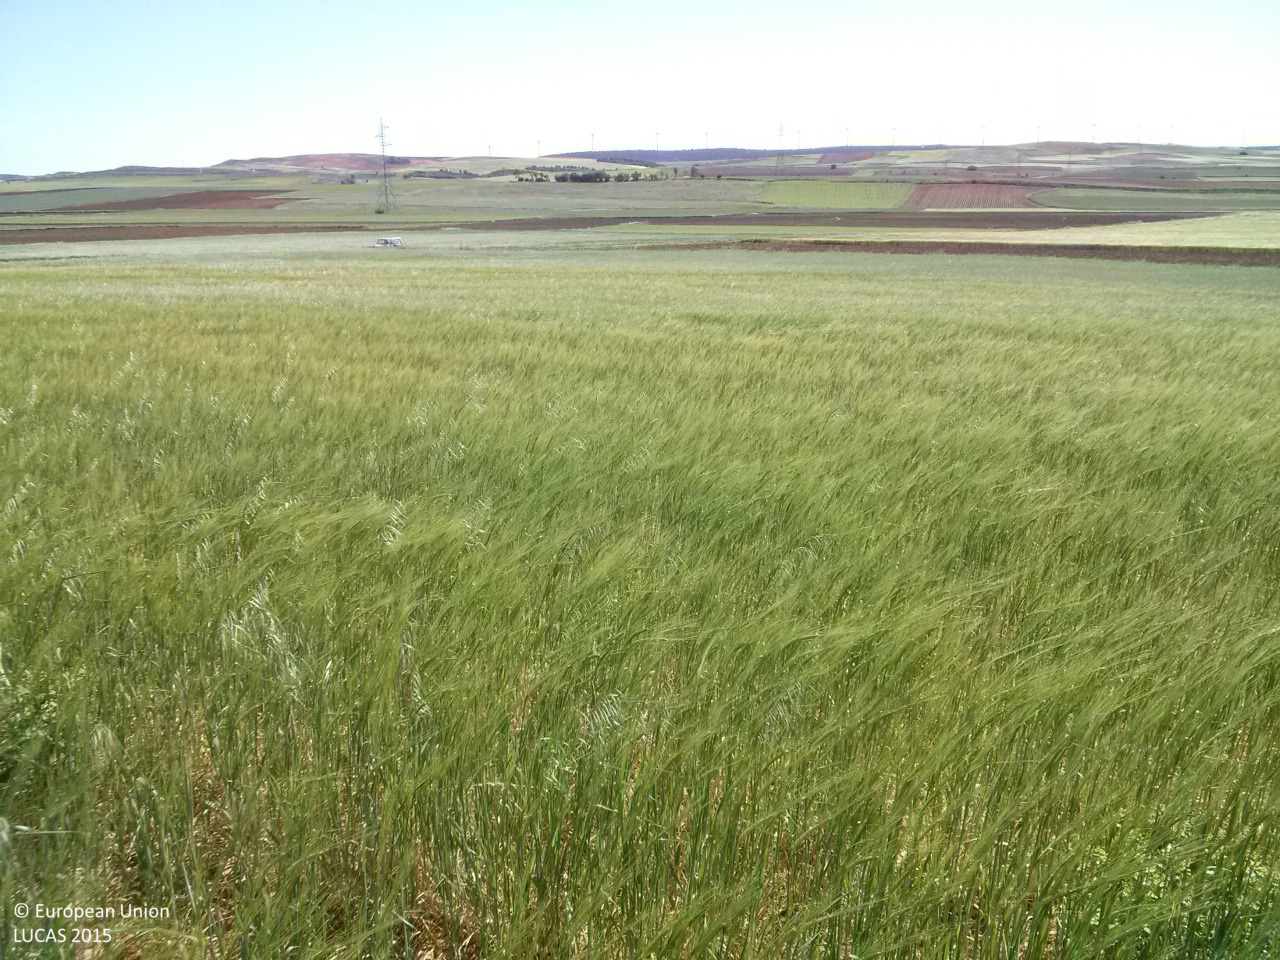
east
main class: Cropland
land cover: Barley
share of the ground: > 75 %
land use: Agriculture (excluding fallow land and kitchen gardens)
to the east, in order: Barley; Grass margins; Sunflower; Barley; Grass margins; Tracks; Grass margins; Barley; Sunflower
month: May
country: ES
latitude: 40.0072
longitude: -2.8257
